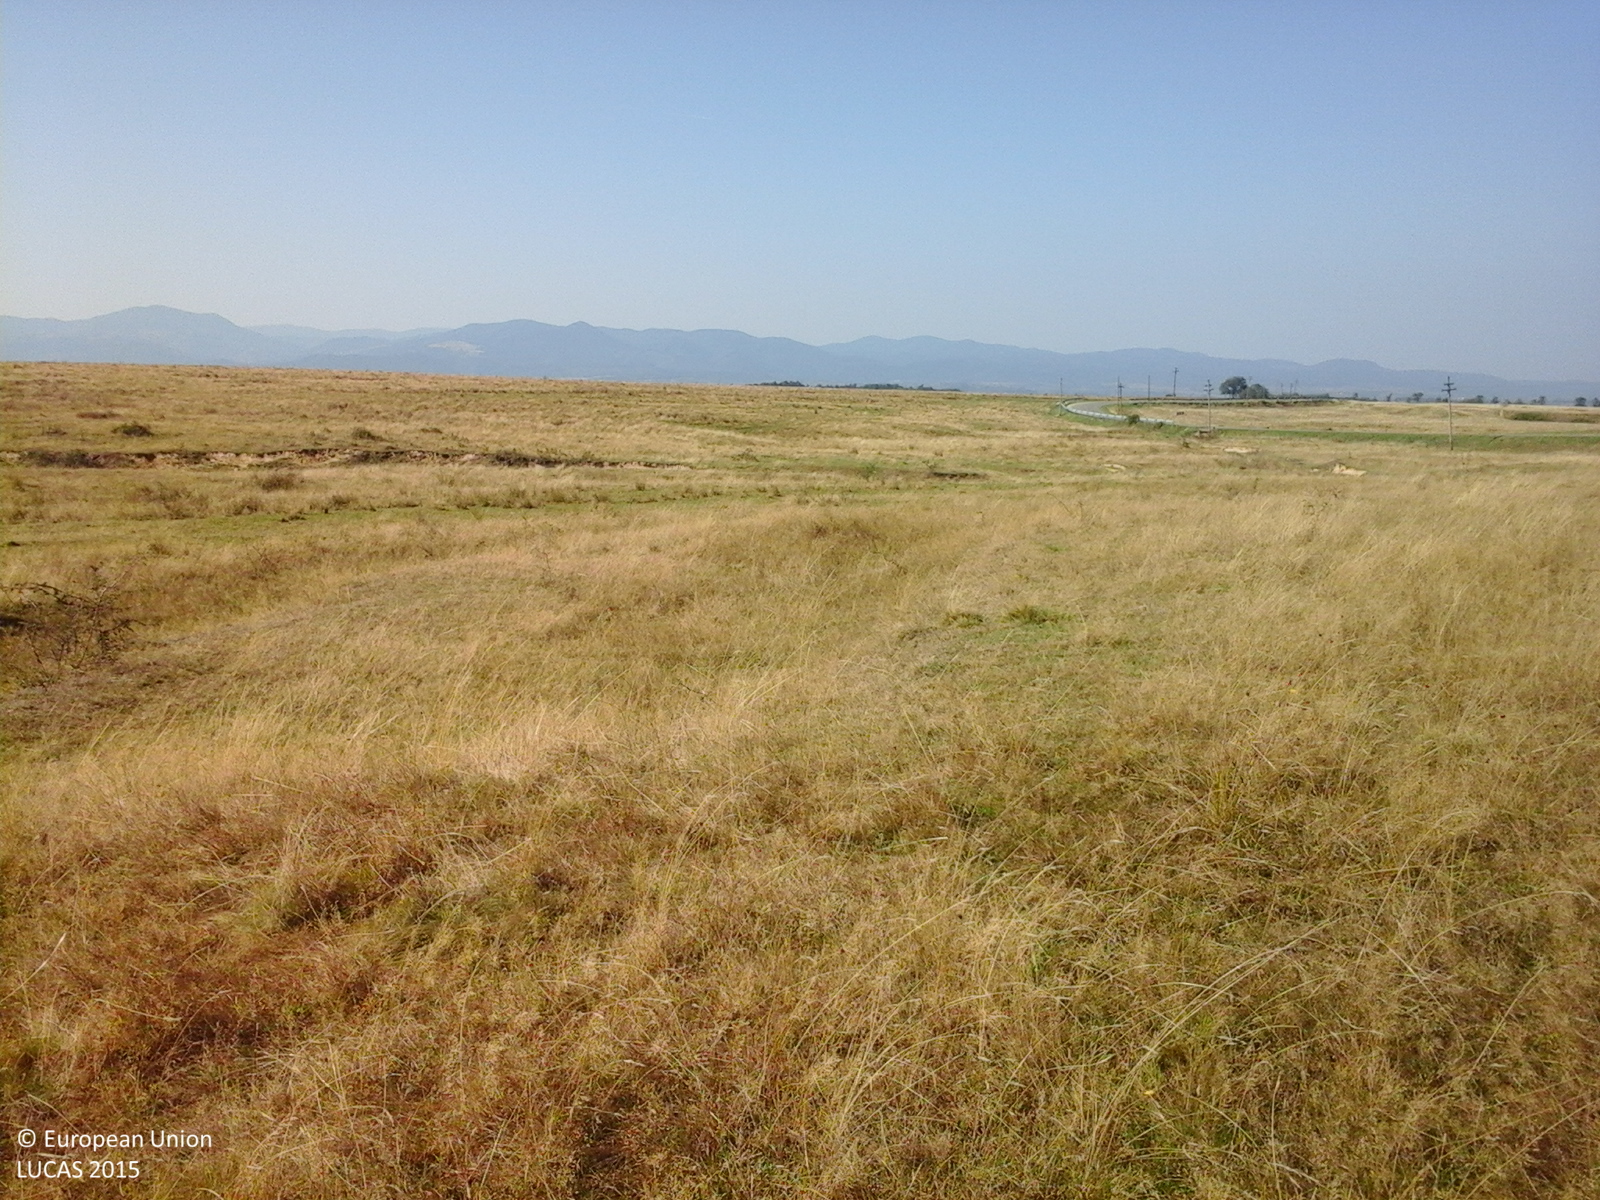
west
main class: Grassland
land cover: Grassland without tree/shrub cover
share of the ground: > 75 %
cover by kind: herbaceous plants 100 %
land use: Agriculture (excluding fallow land and kitchen gardens)
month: September
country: RO
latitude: 46.6761
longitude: 22.4576
